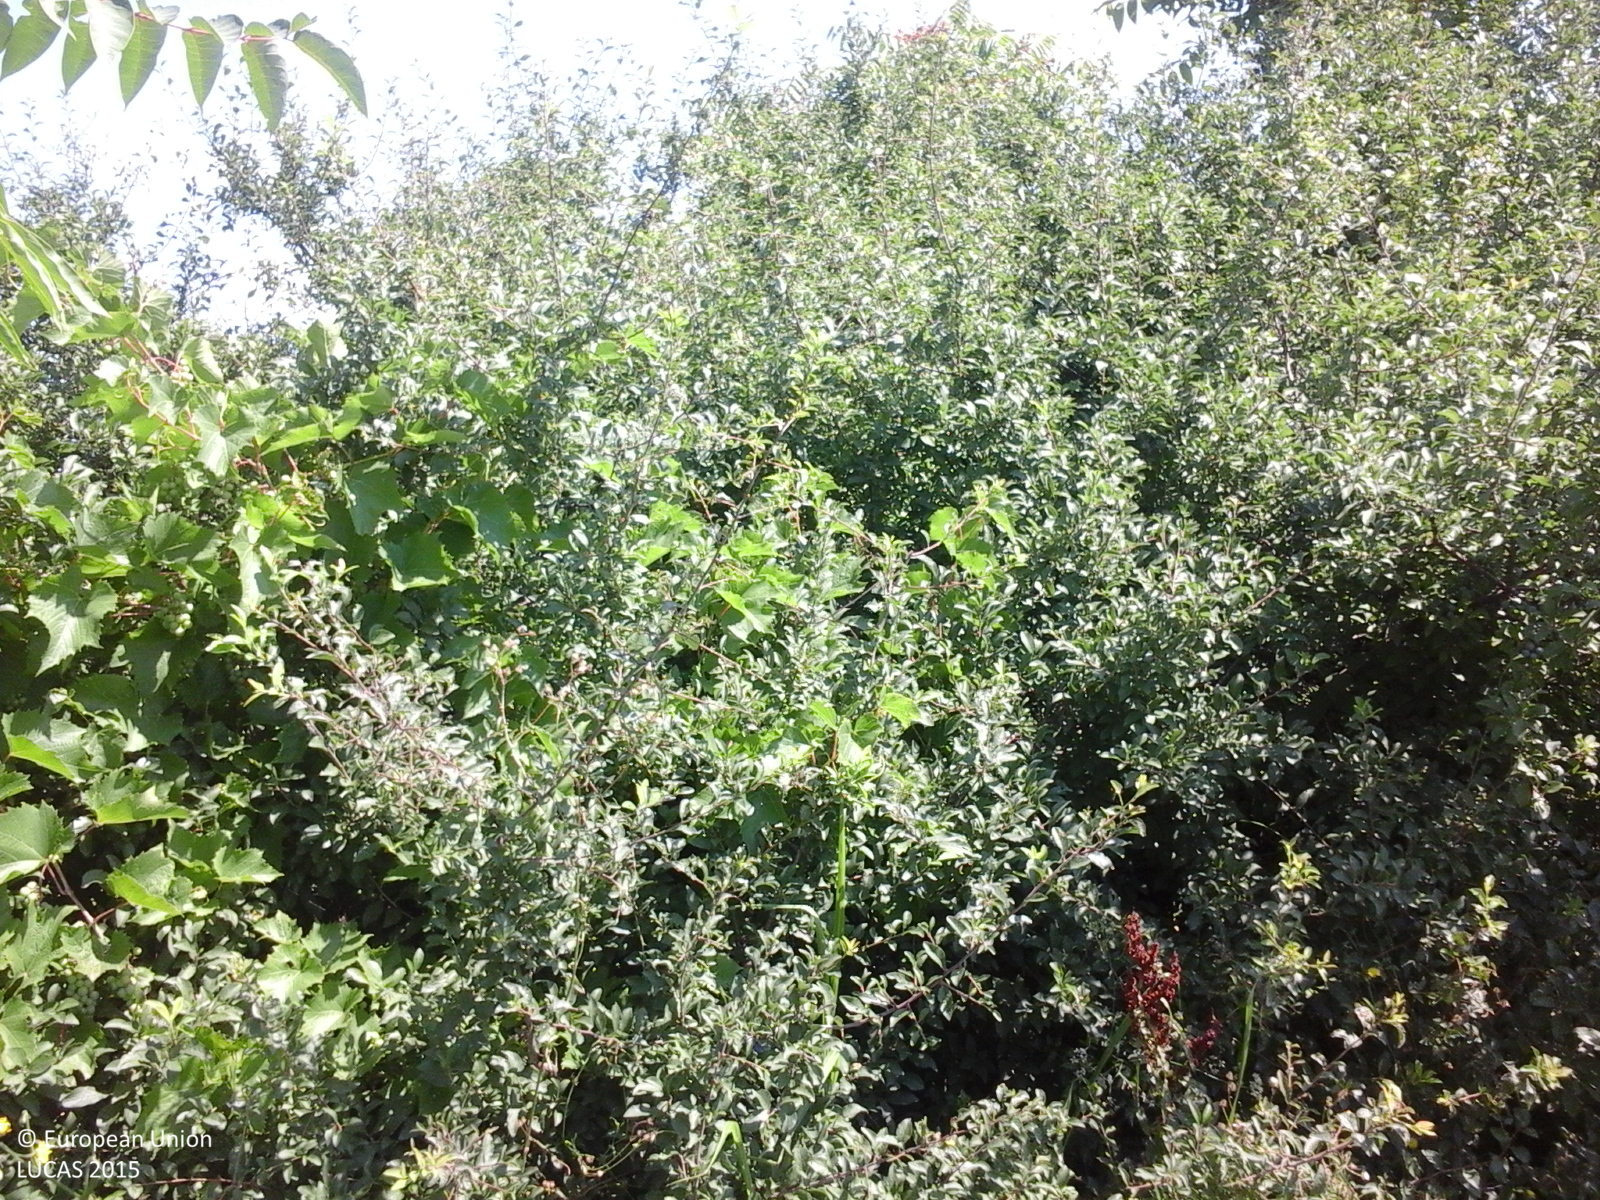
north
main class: Grassland
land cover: Spontaneously vegetated surfaces
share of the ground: 50 - 75 %
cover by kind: herbaceous plants 95 %, shrubs 5 %
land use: Fallow land
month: July
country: RO
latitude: 43.9190
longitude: 24.7030
